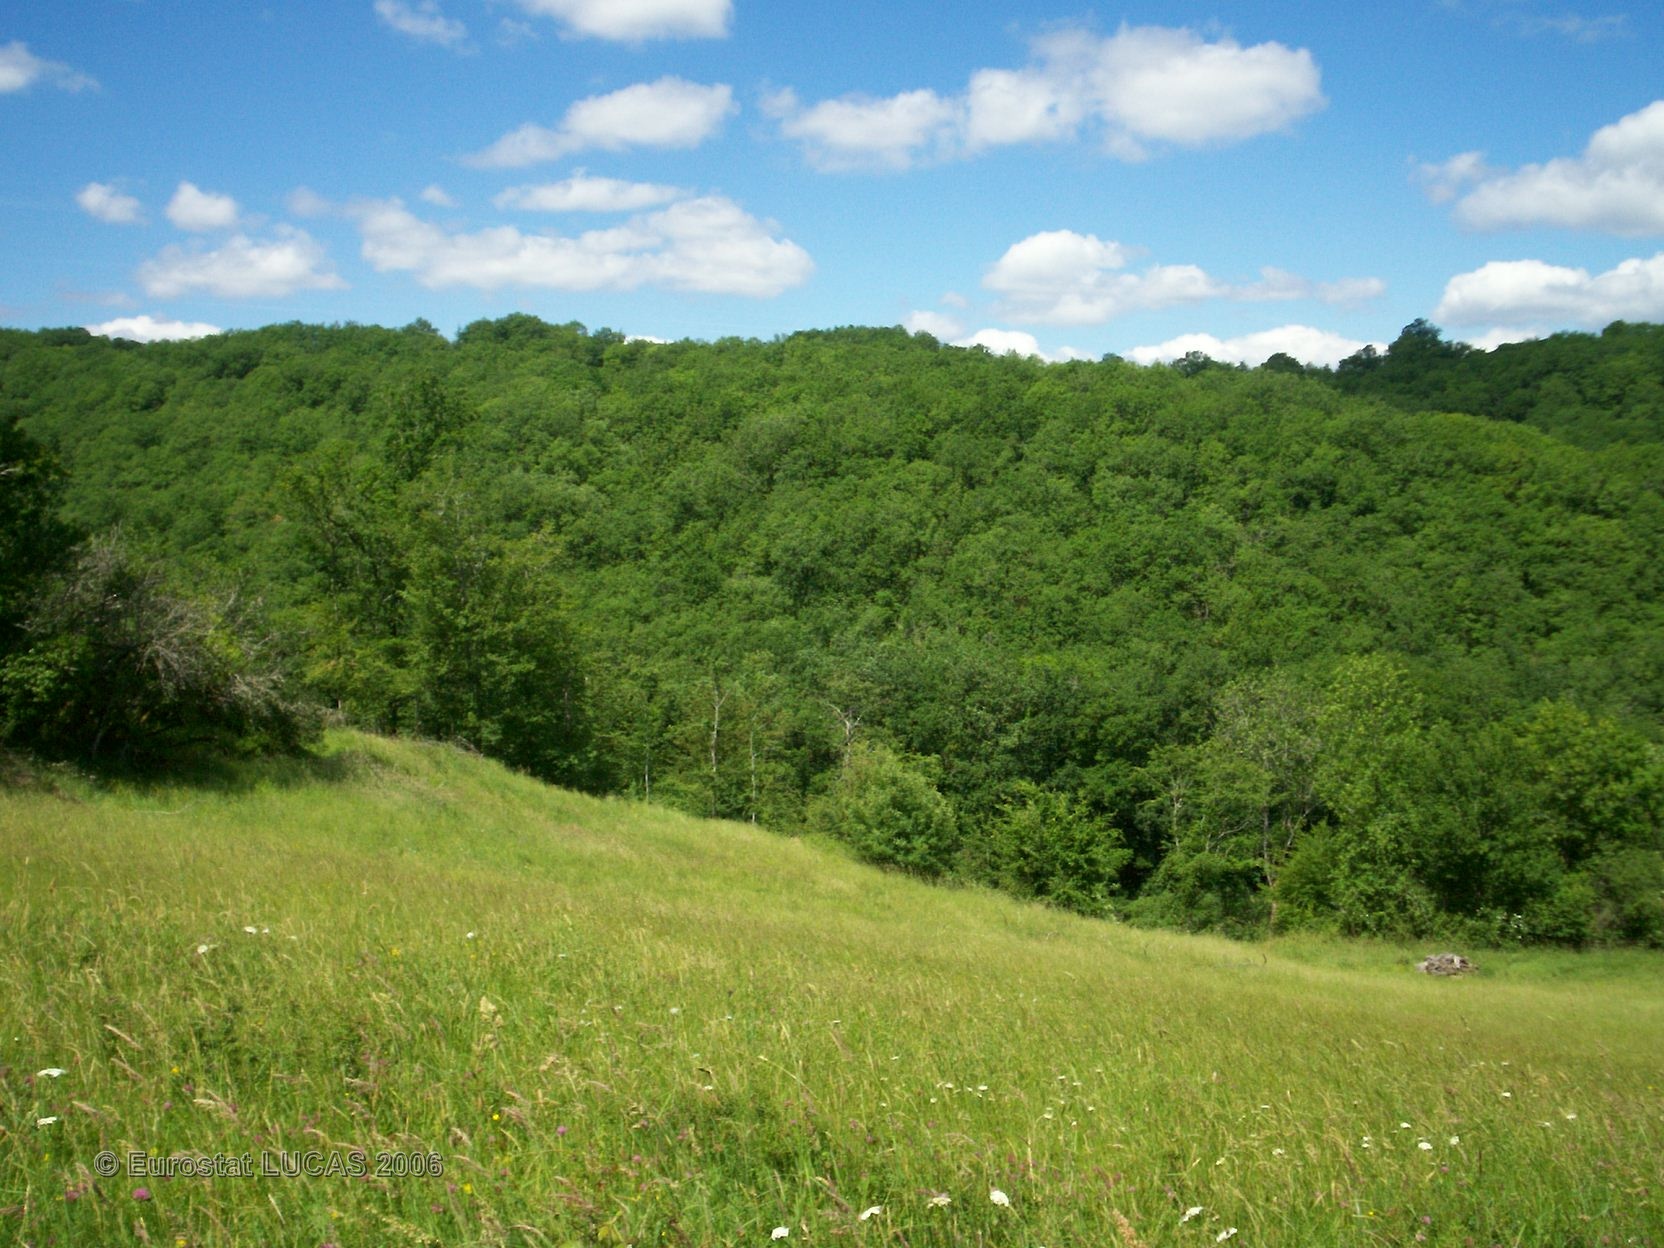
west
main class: Grassland
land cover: Grassland without tree/shrub cover
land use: Agriculture (excluding fallow land and kitchen gardens)
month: May
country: FR
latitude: 44.6265
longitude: 1.3883
